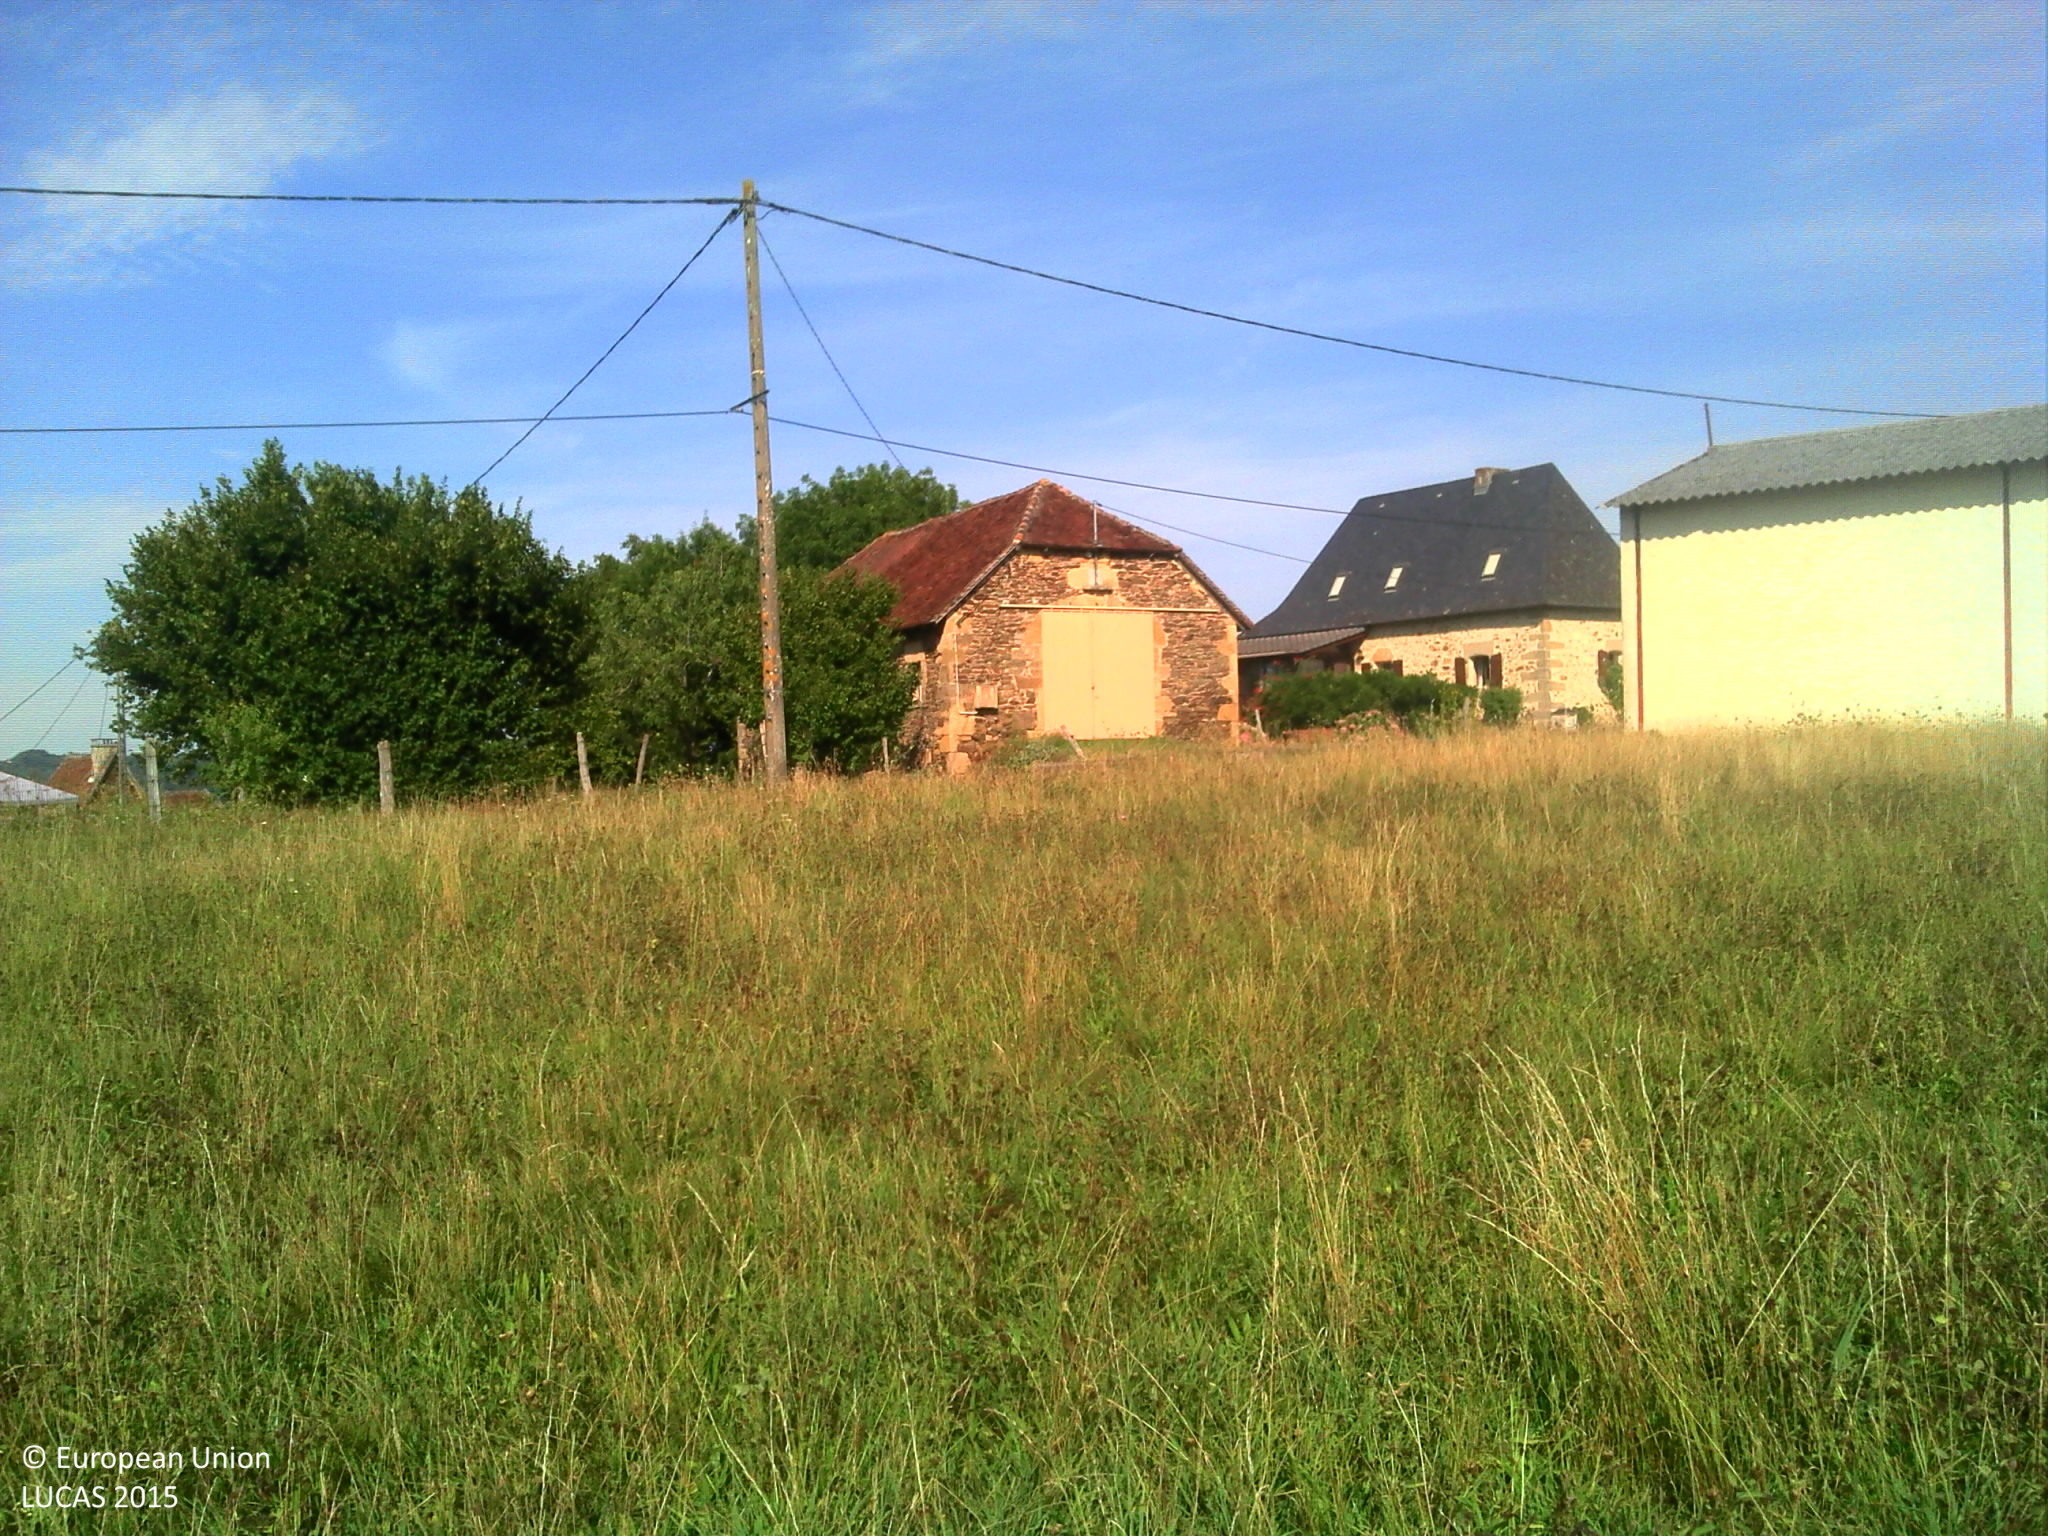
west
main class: Grassland
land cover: Grassland without tree/shrub cover
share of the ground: > 75 %
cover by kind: herbaceous plants 100 %
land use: Agriculture (excluding fallow land and kitchen gardens)
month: August
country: FR
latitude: 44.8178
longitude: 1.9689
